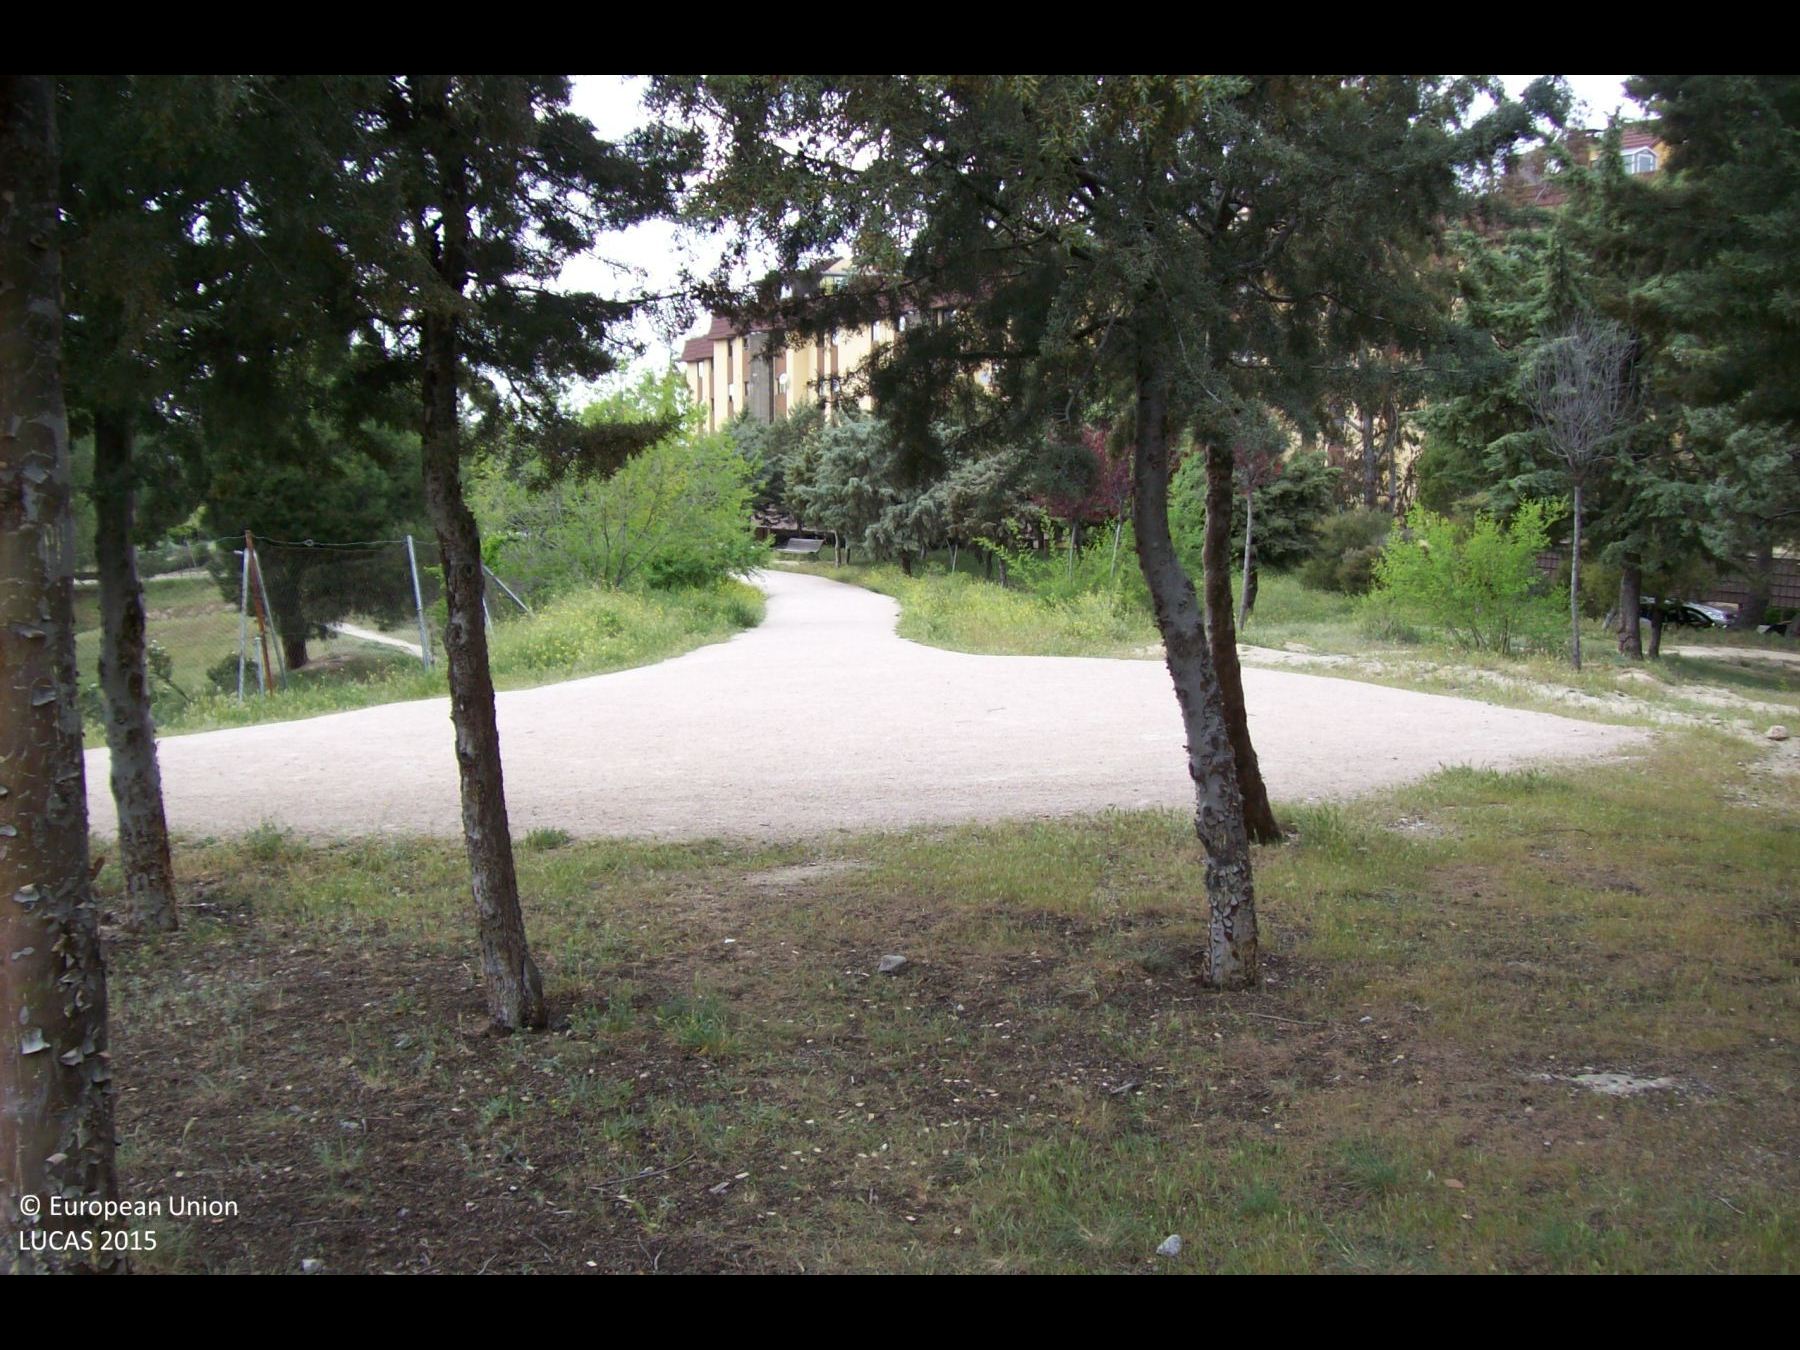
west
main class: Grassland
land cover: Grassland with sparse tree/shrub cover
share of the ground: > 75 %
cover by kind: herbaceous plants 95 %, coniferous forest trees 5 %
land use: Amenities, museums, leisure
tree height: < 5 m
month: April
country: ES
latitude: 40.4850
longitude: -3.8789
